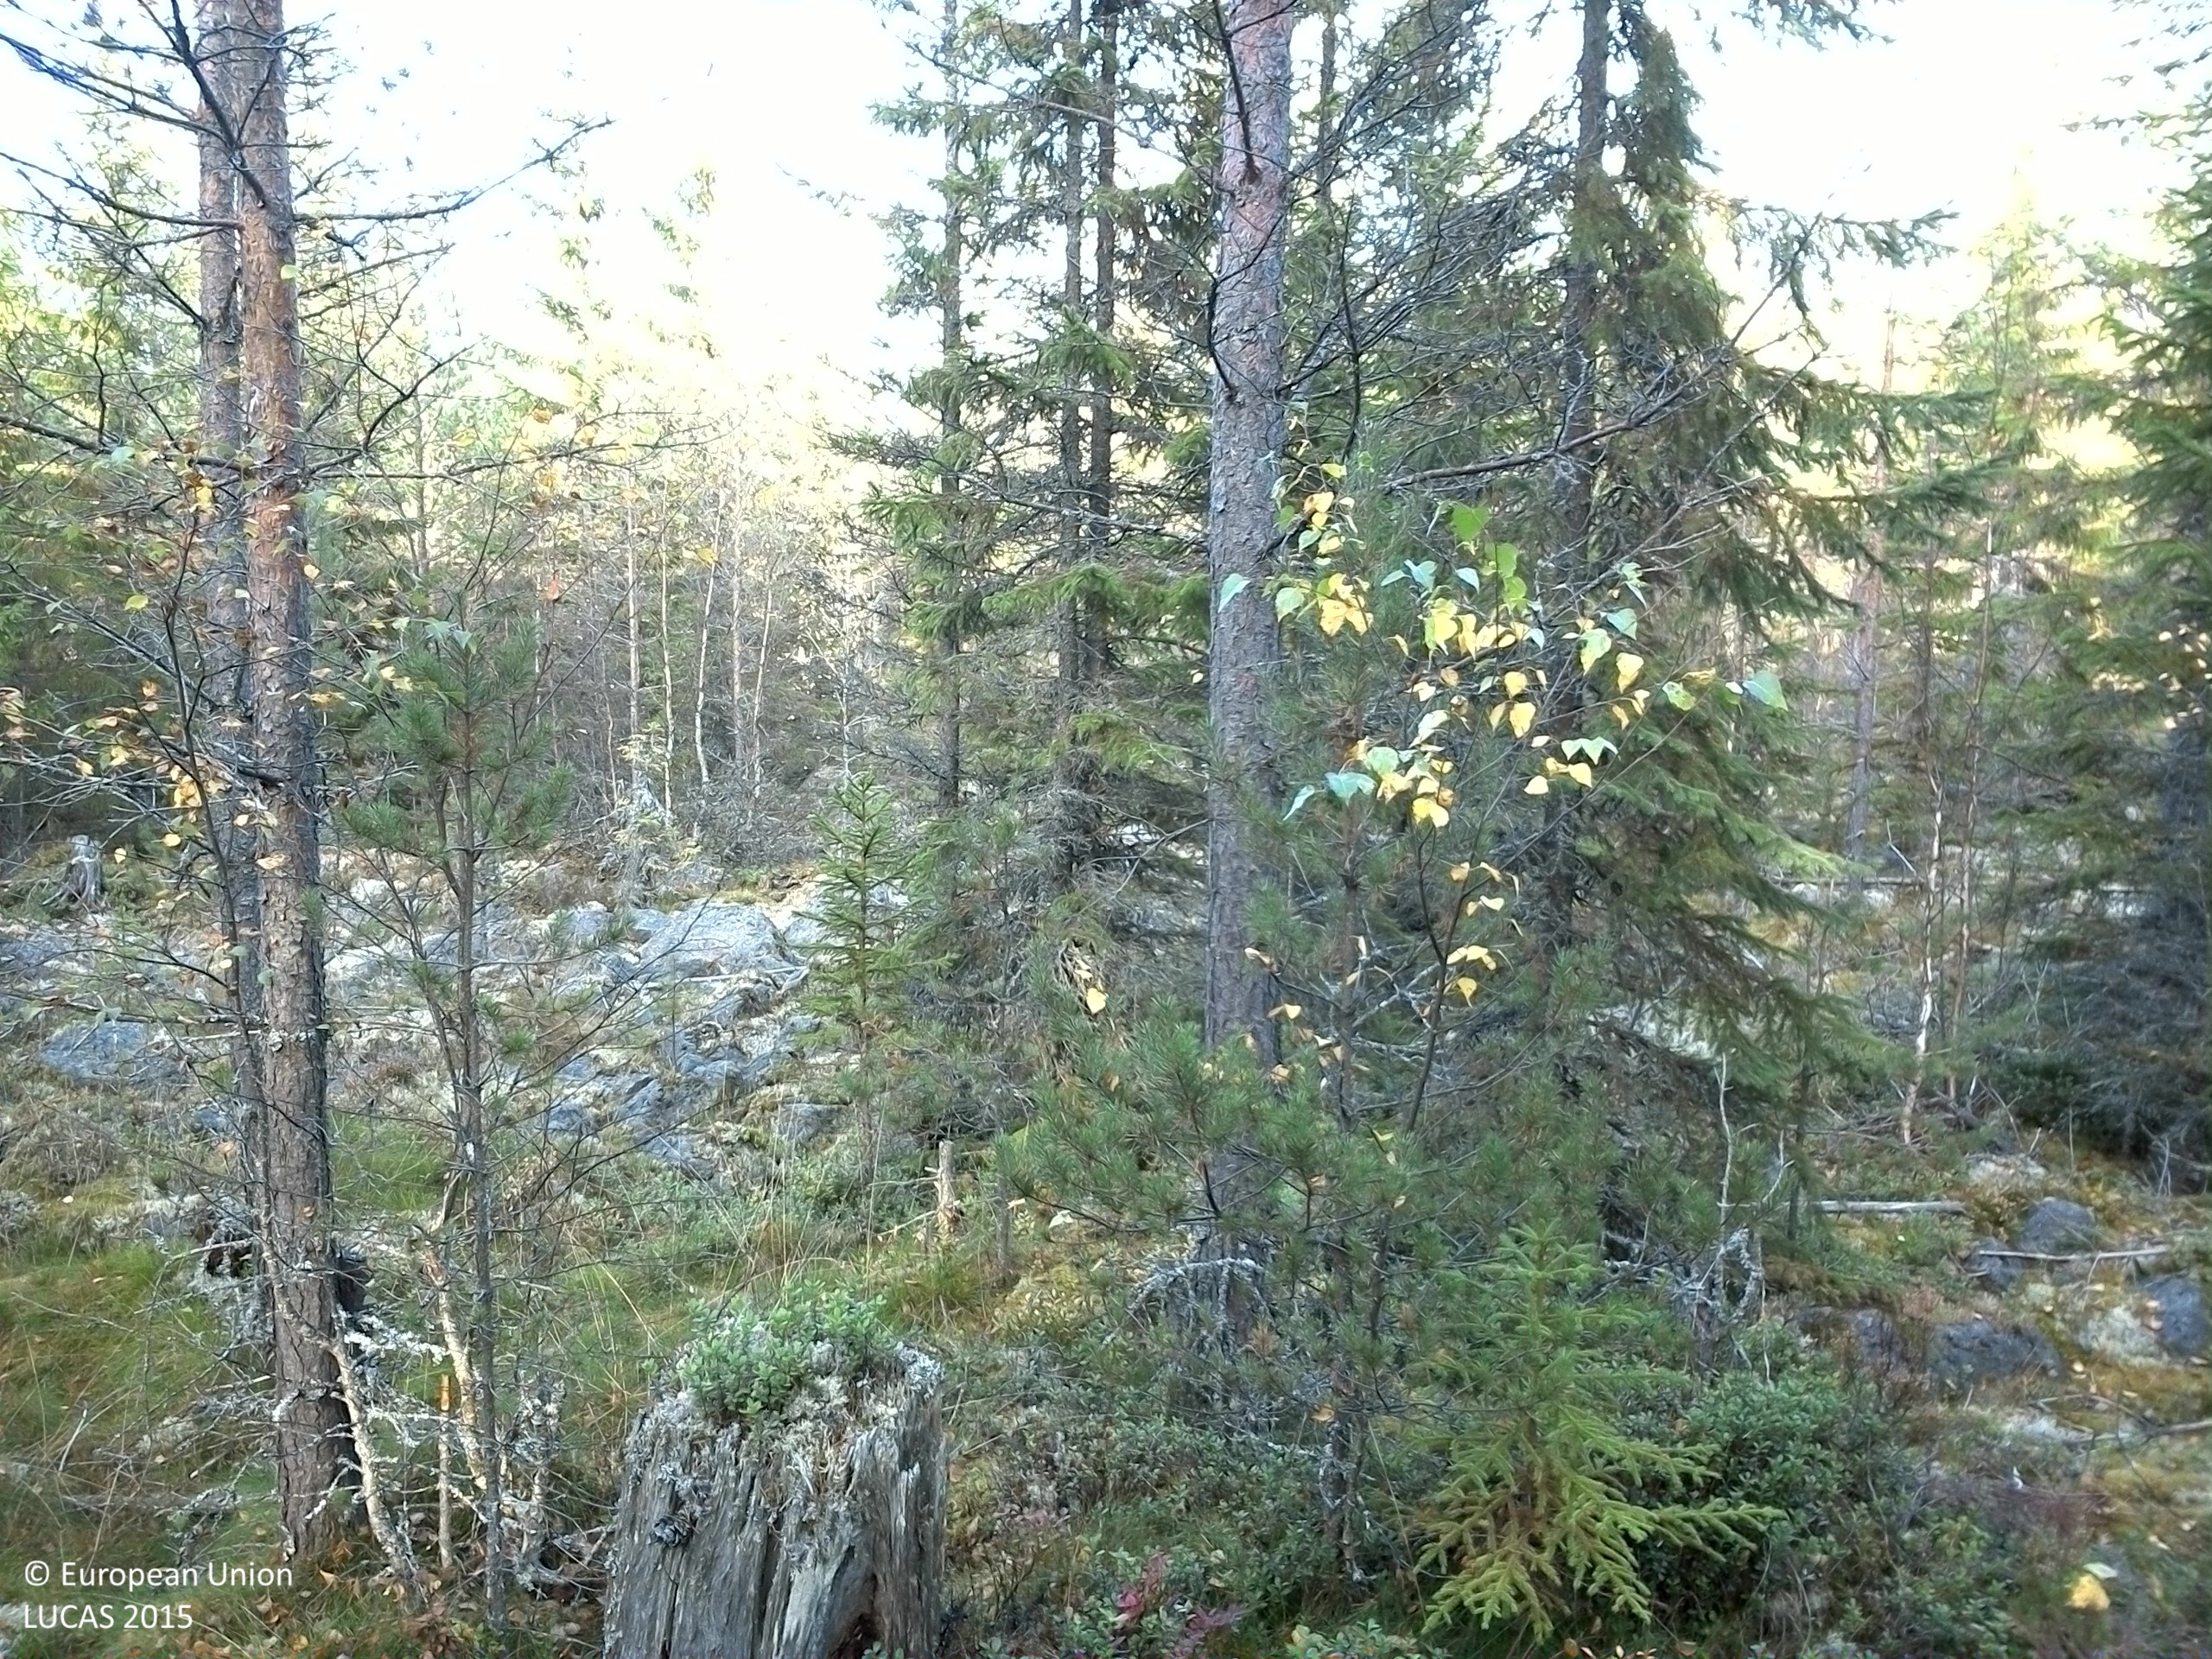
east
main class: Woodland
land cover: Other coniferous woodland
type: boreal forest
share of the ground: 50 - 75 %
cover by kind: coniferous forest trees 55 %, shrubs 25 %, lichens and mosses 10 %, broadleaved forest trees 5 %, consolidated bare surface 5 %
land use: Forestry
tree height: > 5 m
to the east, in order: Other coniferous woodland; Pine dominated coniferous woodland; Rocks and stones; Pine dominated coniferous woodland; Pine dominated mixed woodland; Pine dominated coniferous woodland; Peatbogs
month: October
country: SE
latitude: 61.2805
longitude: 15.0780
